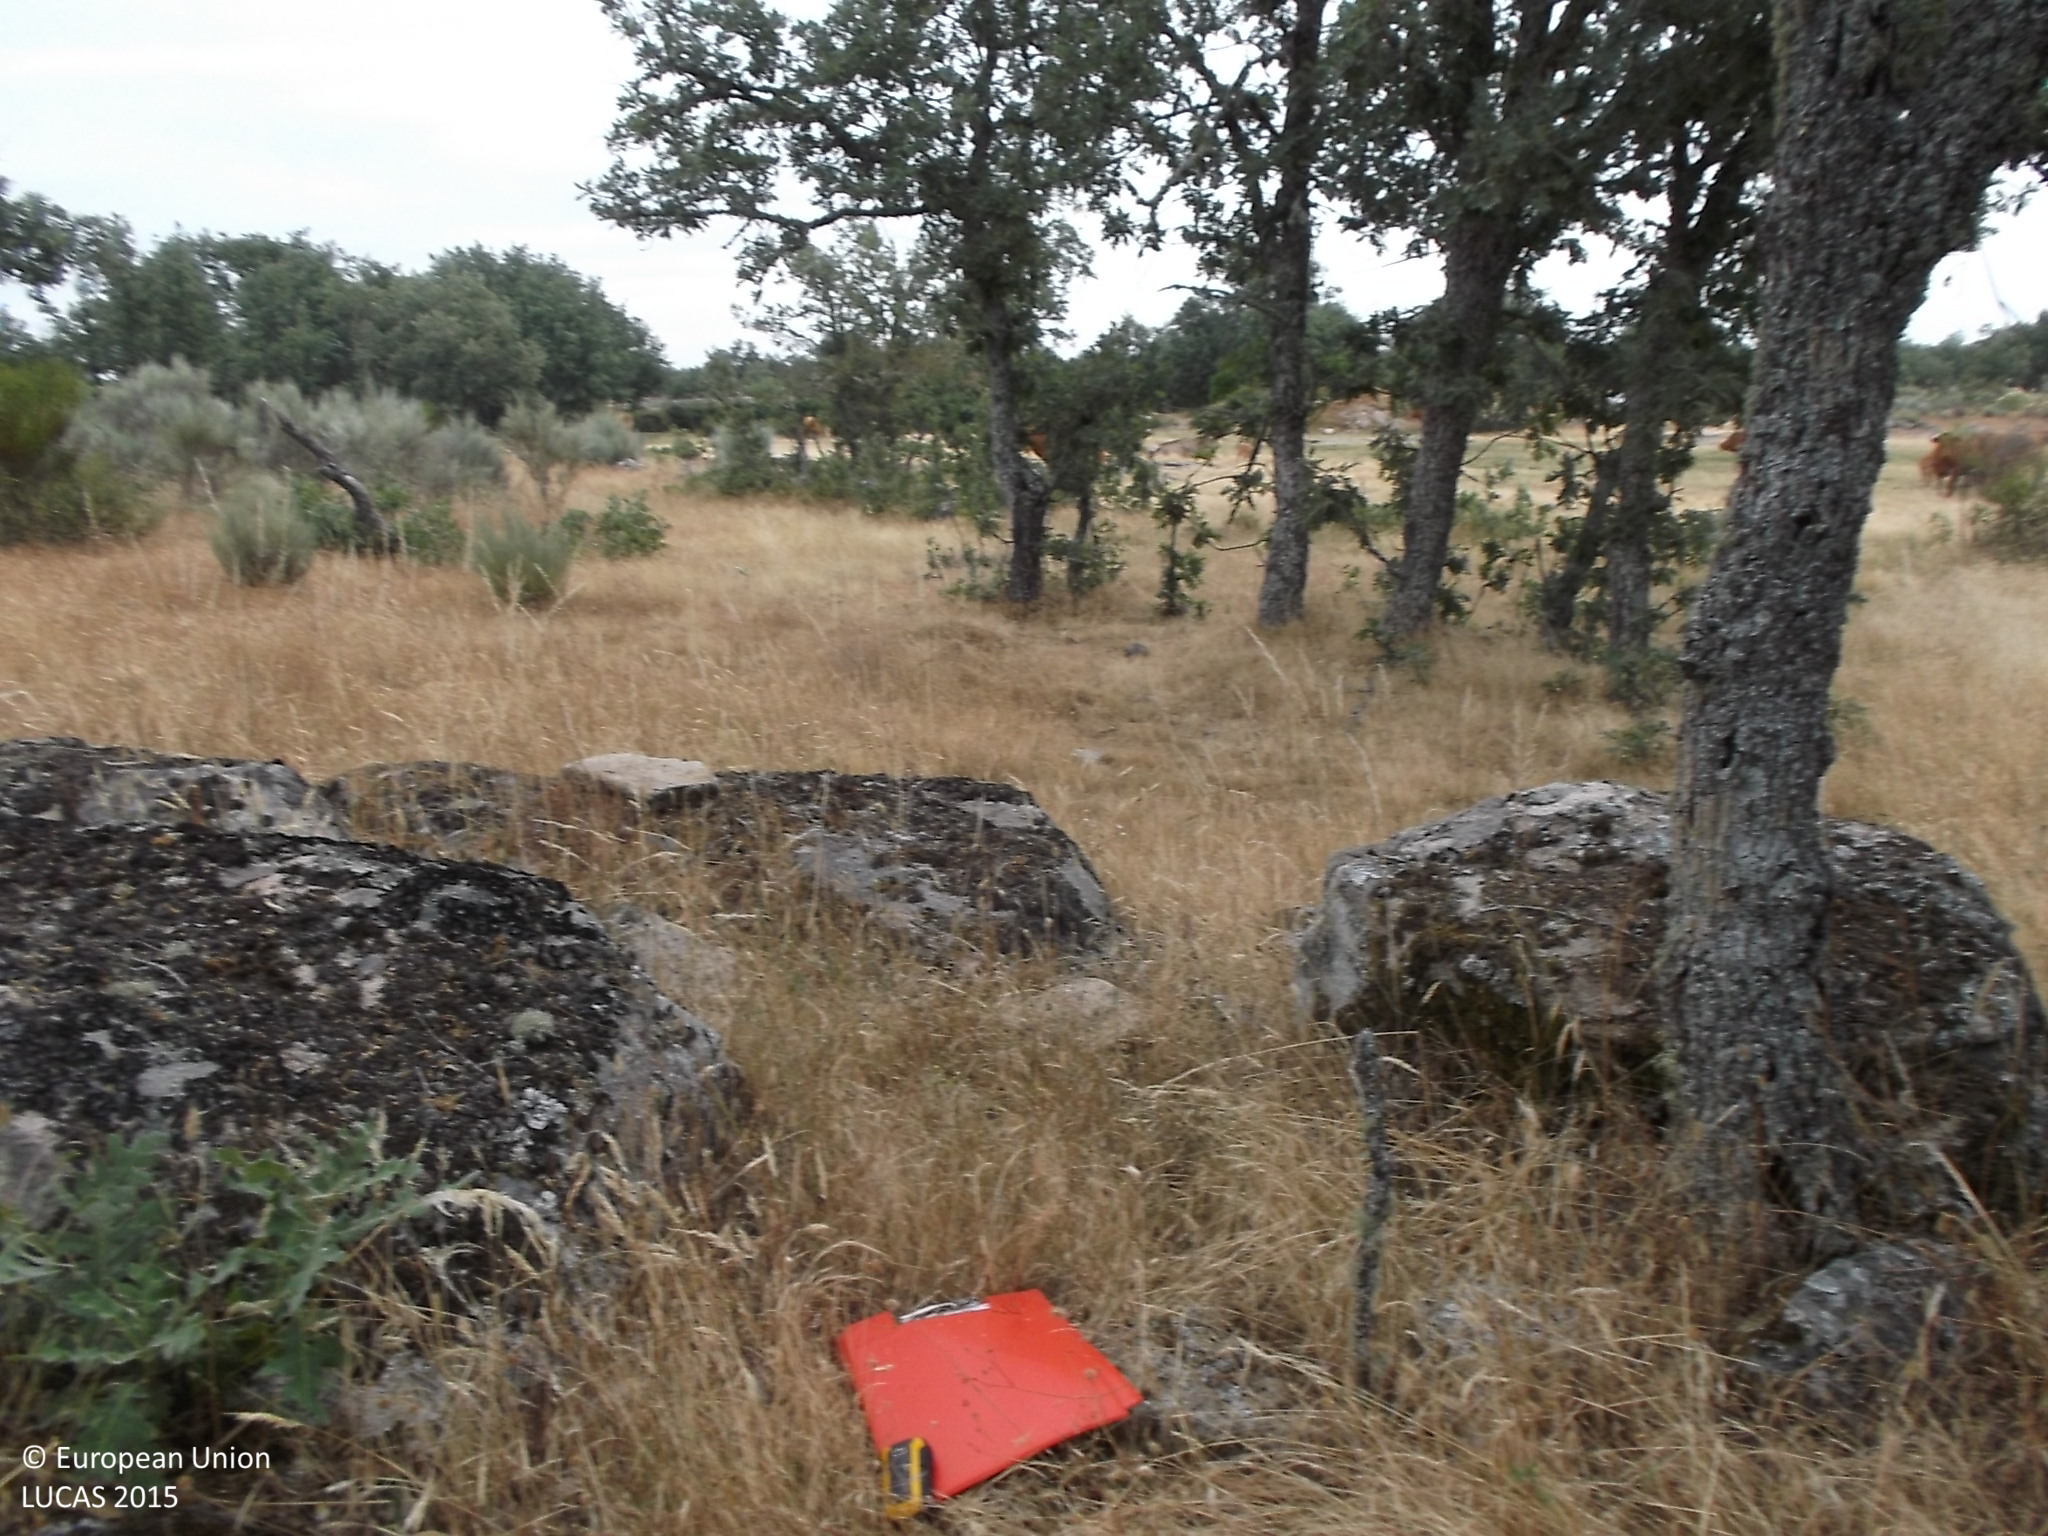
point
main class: Woodland
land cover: Broadleaved woodland
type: broadleaved evergreen forest
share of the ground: 25 - 50 %
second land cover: Grassland without tree/shrub cover
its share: 25 - 50 %
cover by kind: broadleaved forest trees 40 %, herbaceous plants 40 %, shrubs 20 %
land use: Forestry
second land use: Agriculture (excluding fallow land and kitchen gardens)
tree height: < 5 m
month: July
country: ES
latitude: 41.2007
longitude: -6.3727
